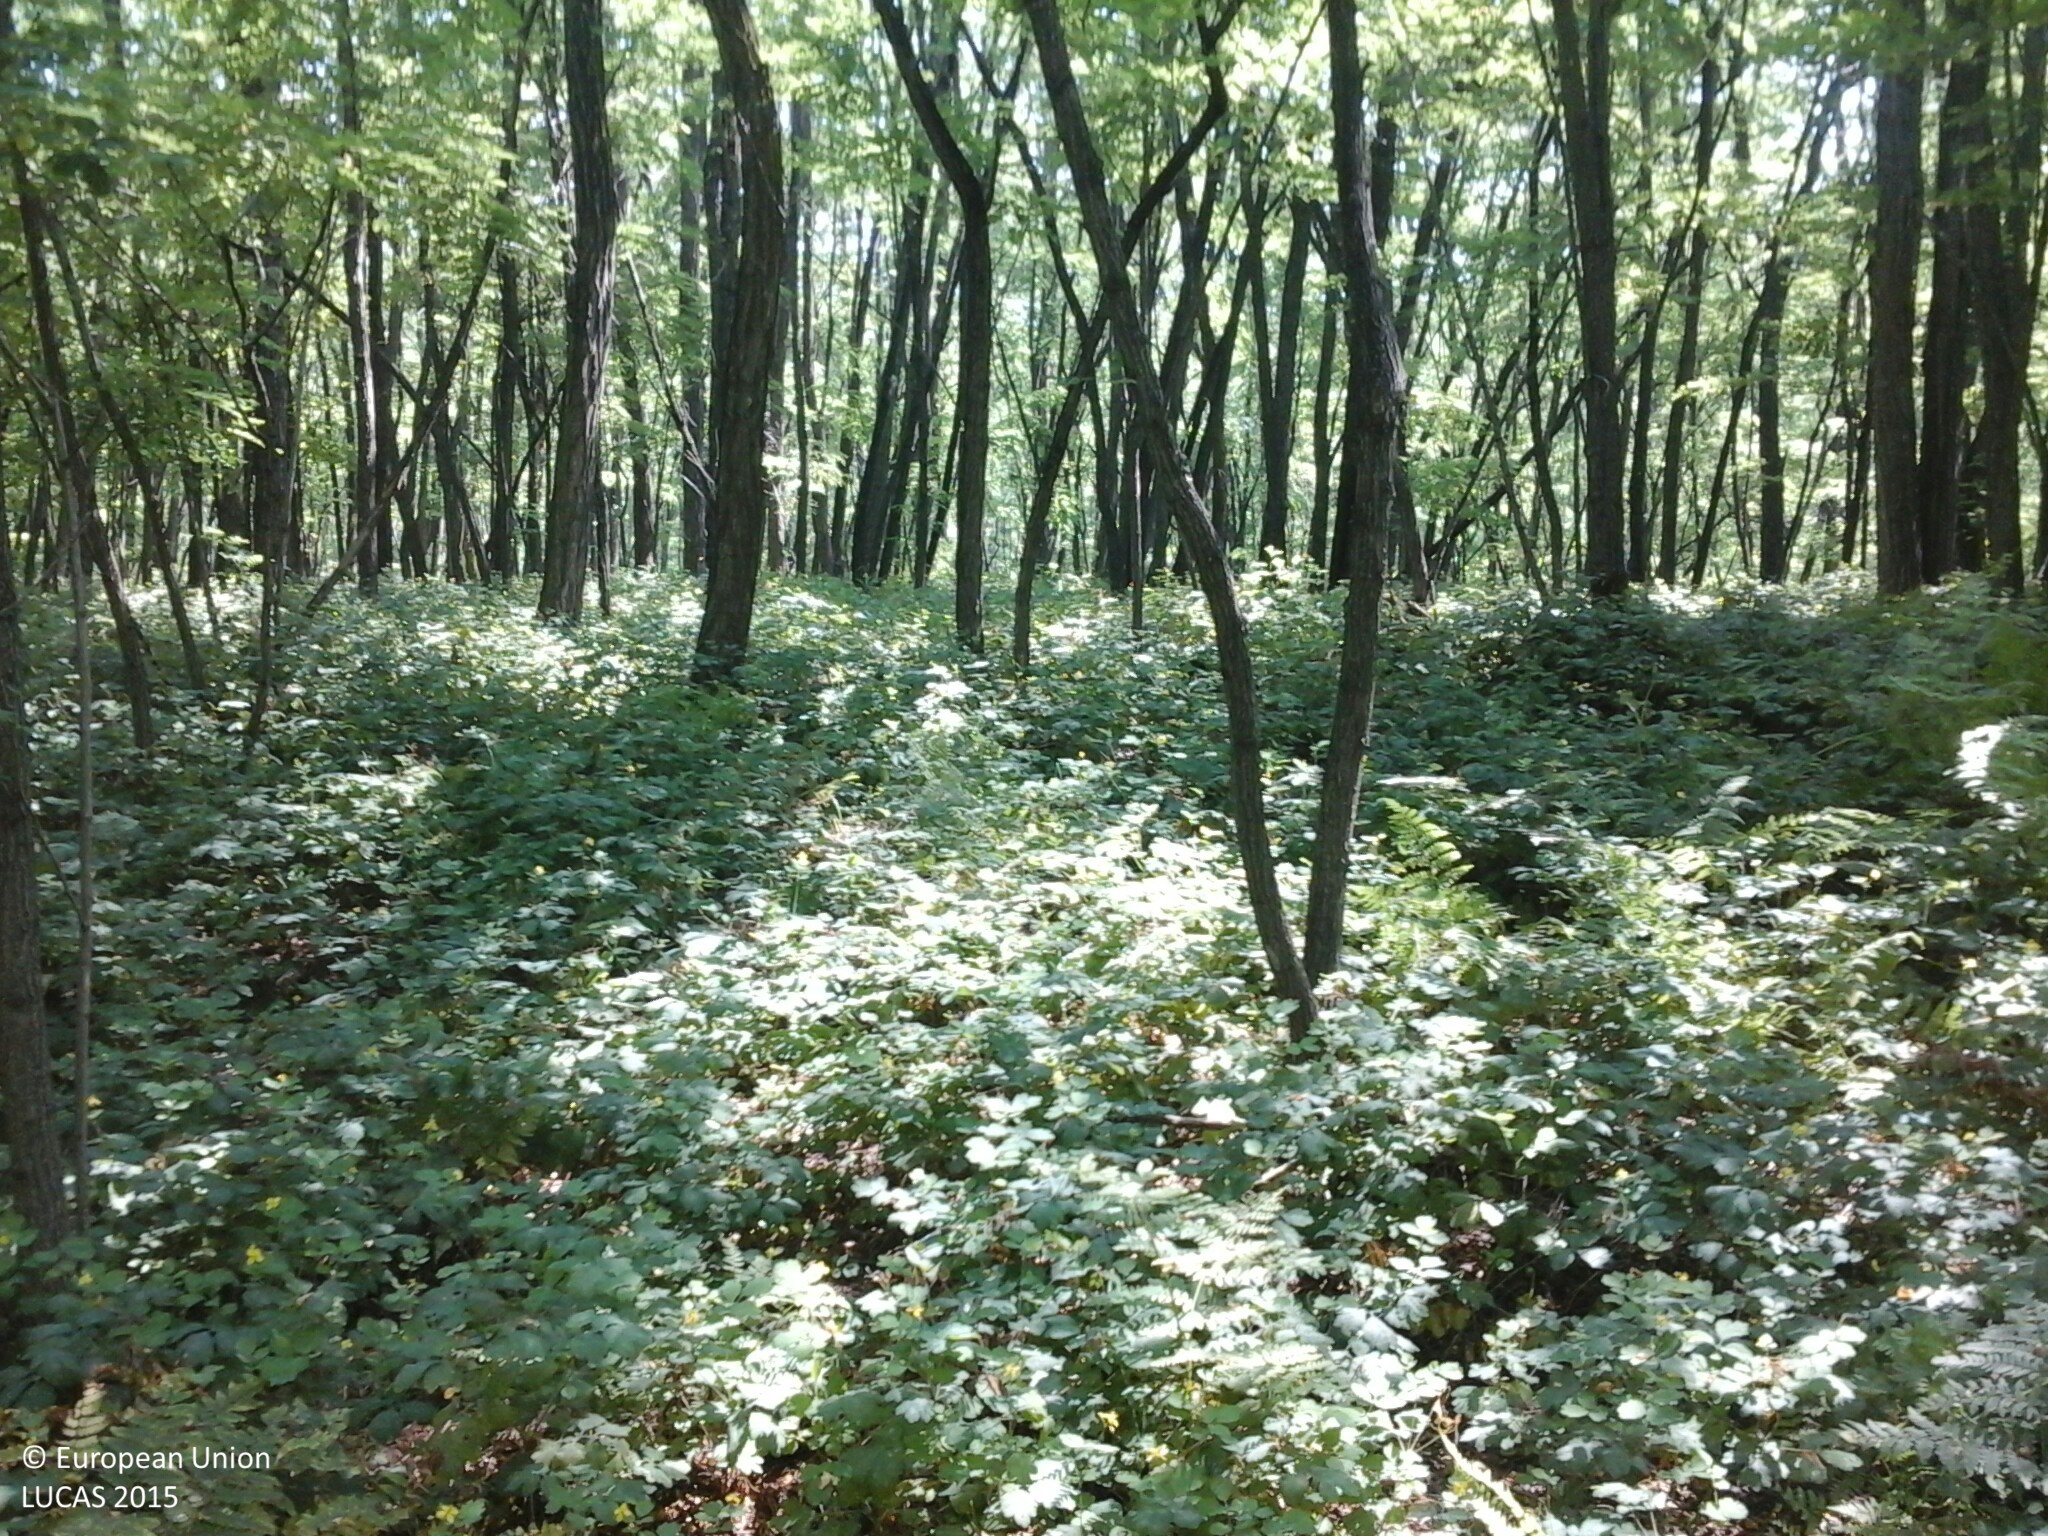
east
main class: Woodland
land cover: Broadleaved woodland
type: exotic forest
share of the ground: > 75 %
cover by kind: broadleaved forest trees 100 %
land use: Forestry
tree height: > 5 m
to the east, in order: Broadleaved woodland; Tracks; Broadleaved woodland
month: July
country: HU
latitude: 48.1414
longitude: 22.2184
